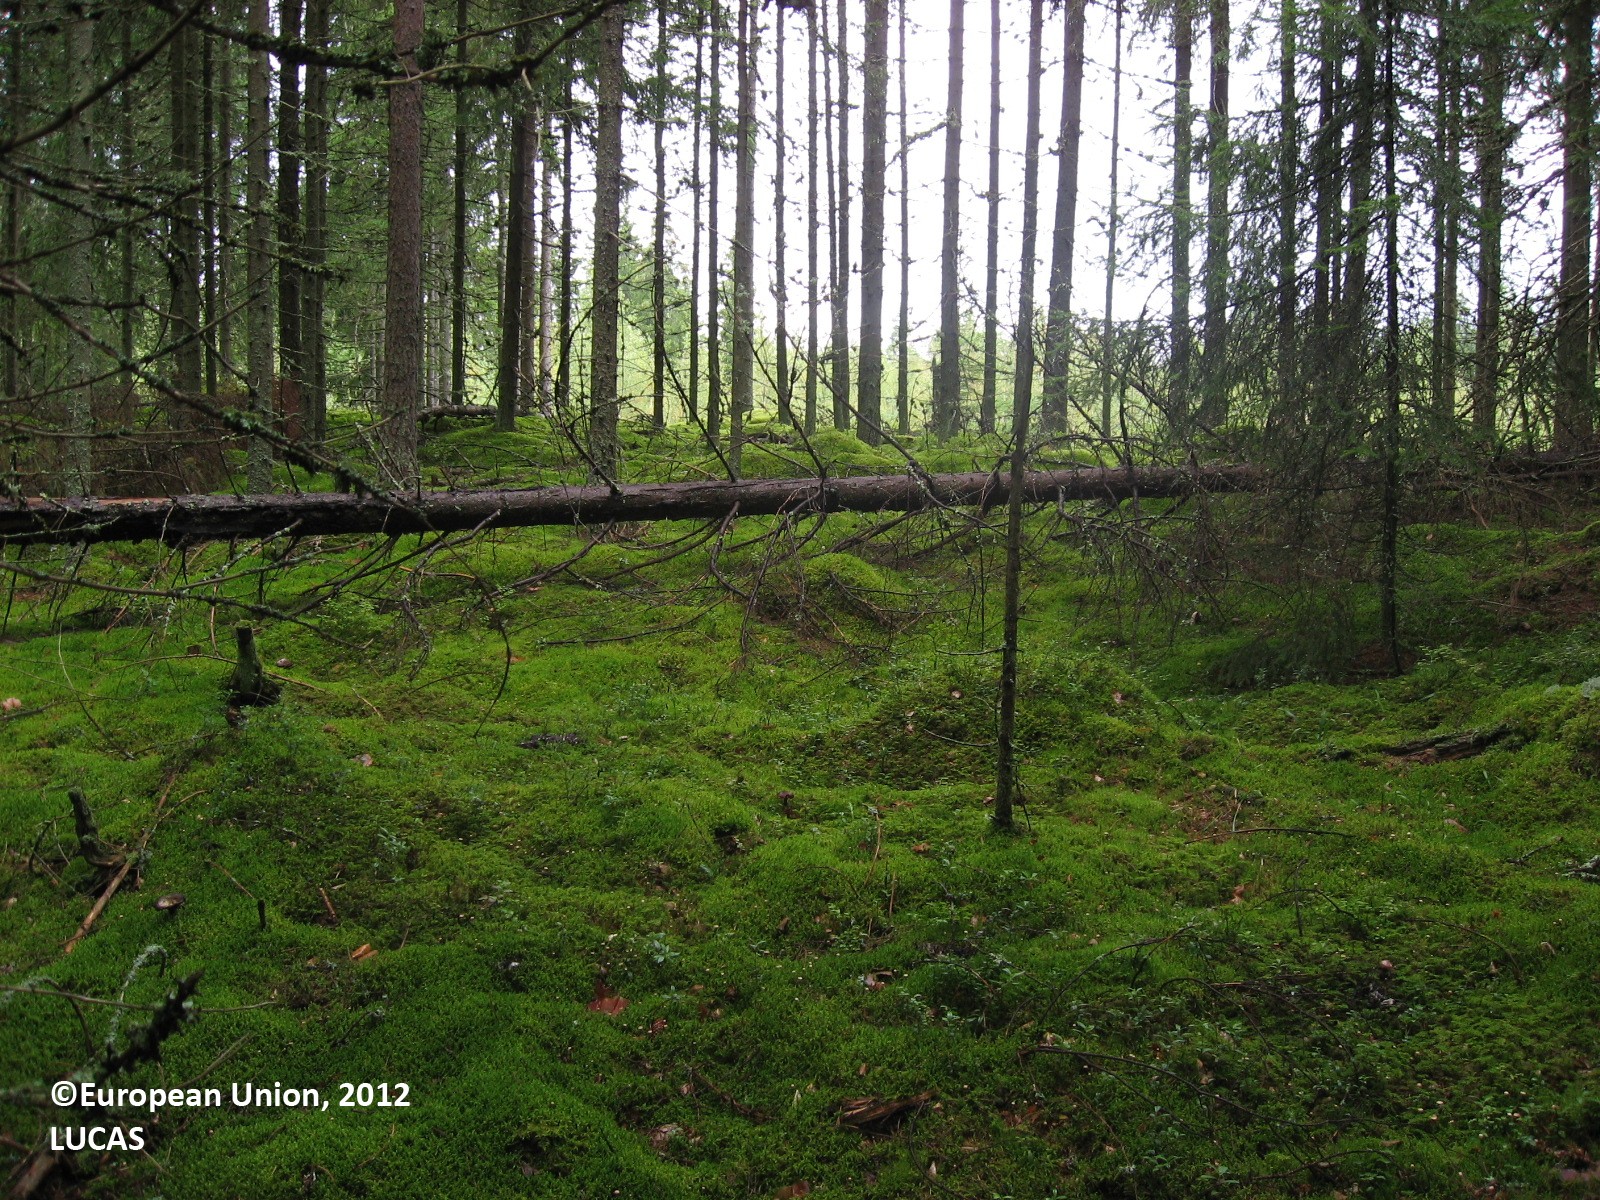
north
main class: Woodland
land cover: Spruce dominated coniferous woodland
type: boreal forest
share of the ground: > 75 %
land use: Forestry
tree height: > 5 m
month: August
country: FI
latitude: 60.6694
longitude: 25.0697
